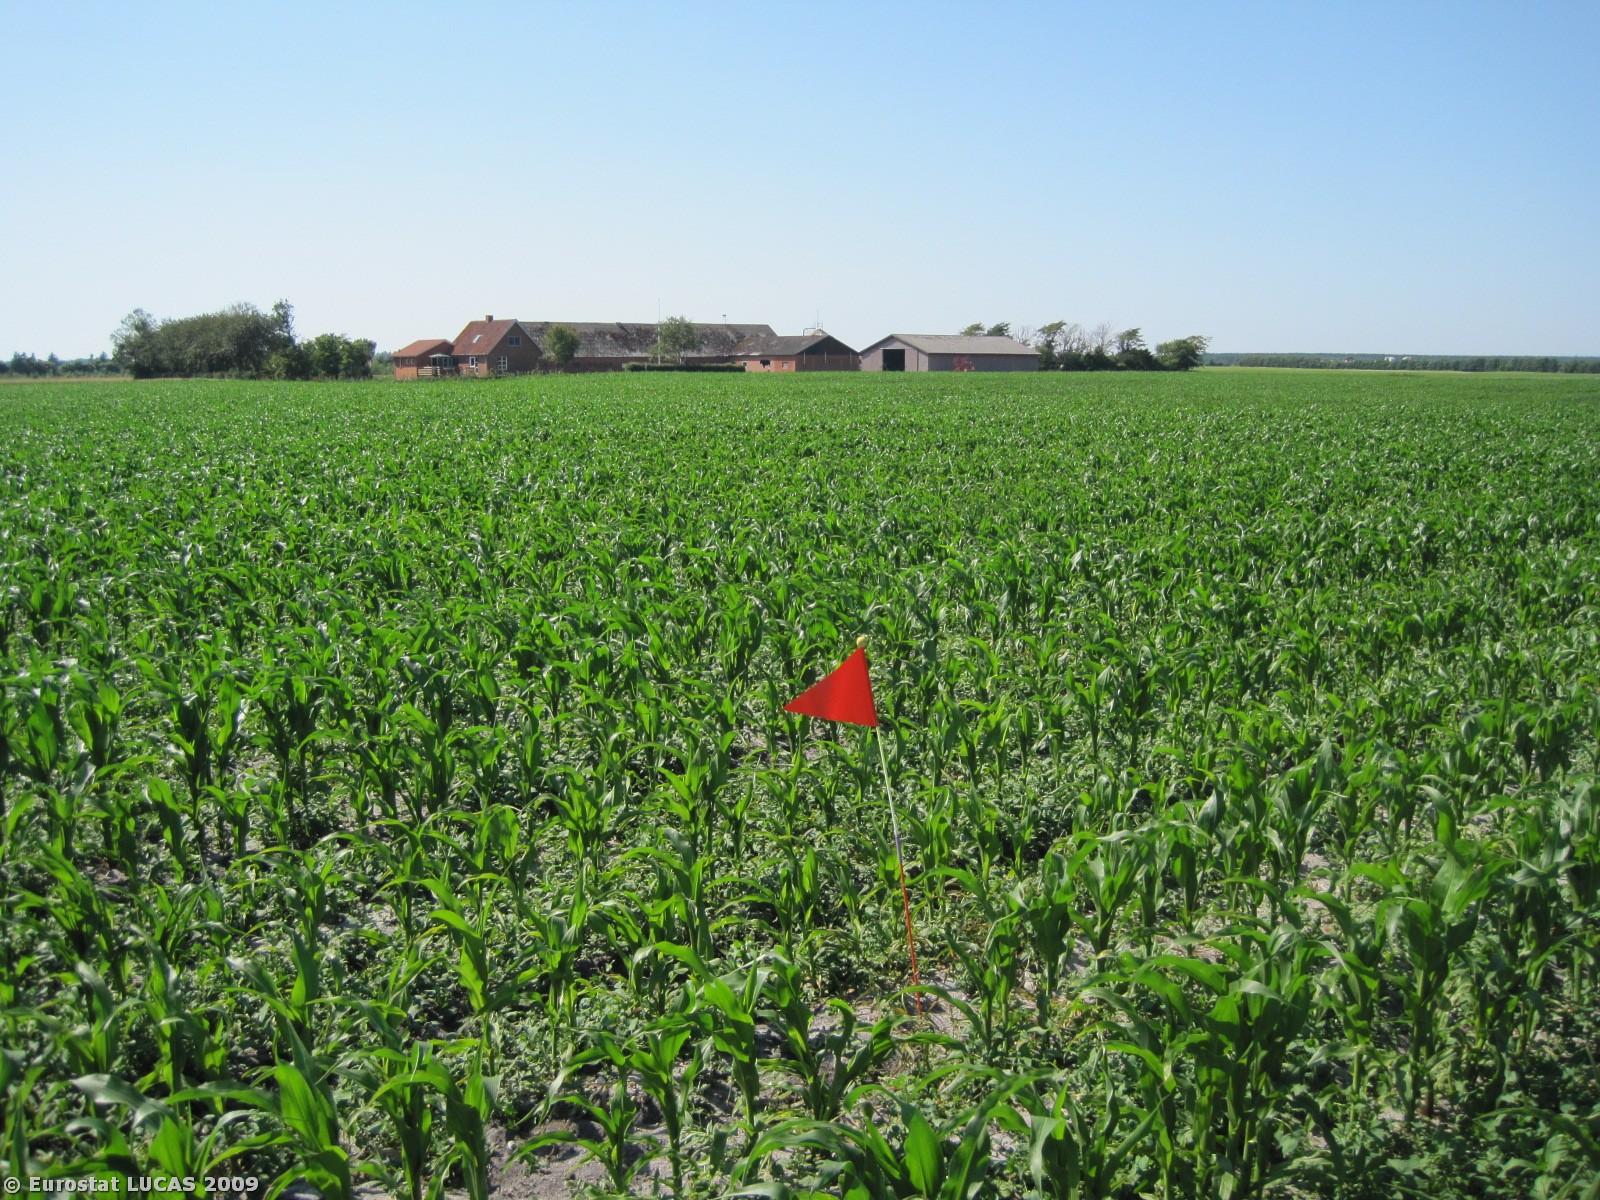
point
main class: Cropland
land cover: Maize
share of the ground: 25 - 50 %
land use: Agriculture (excluding fallow land and kitchen gardens)
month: July
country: DK
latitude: 56.3939
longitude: 8.4305
